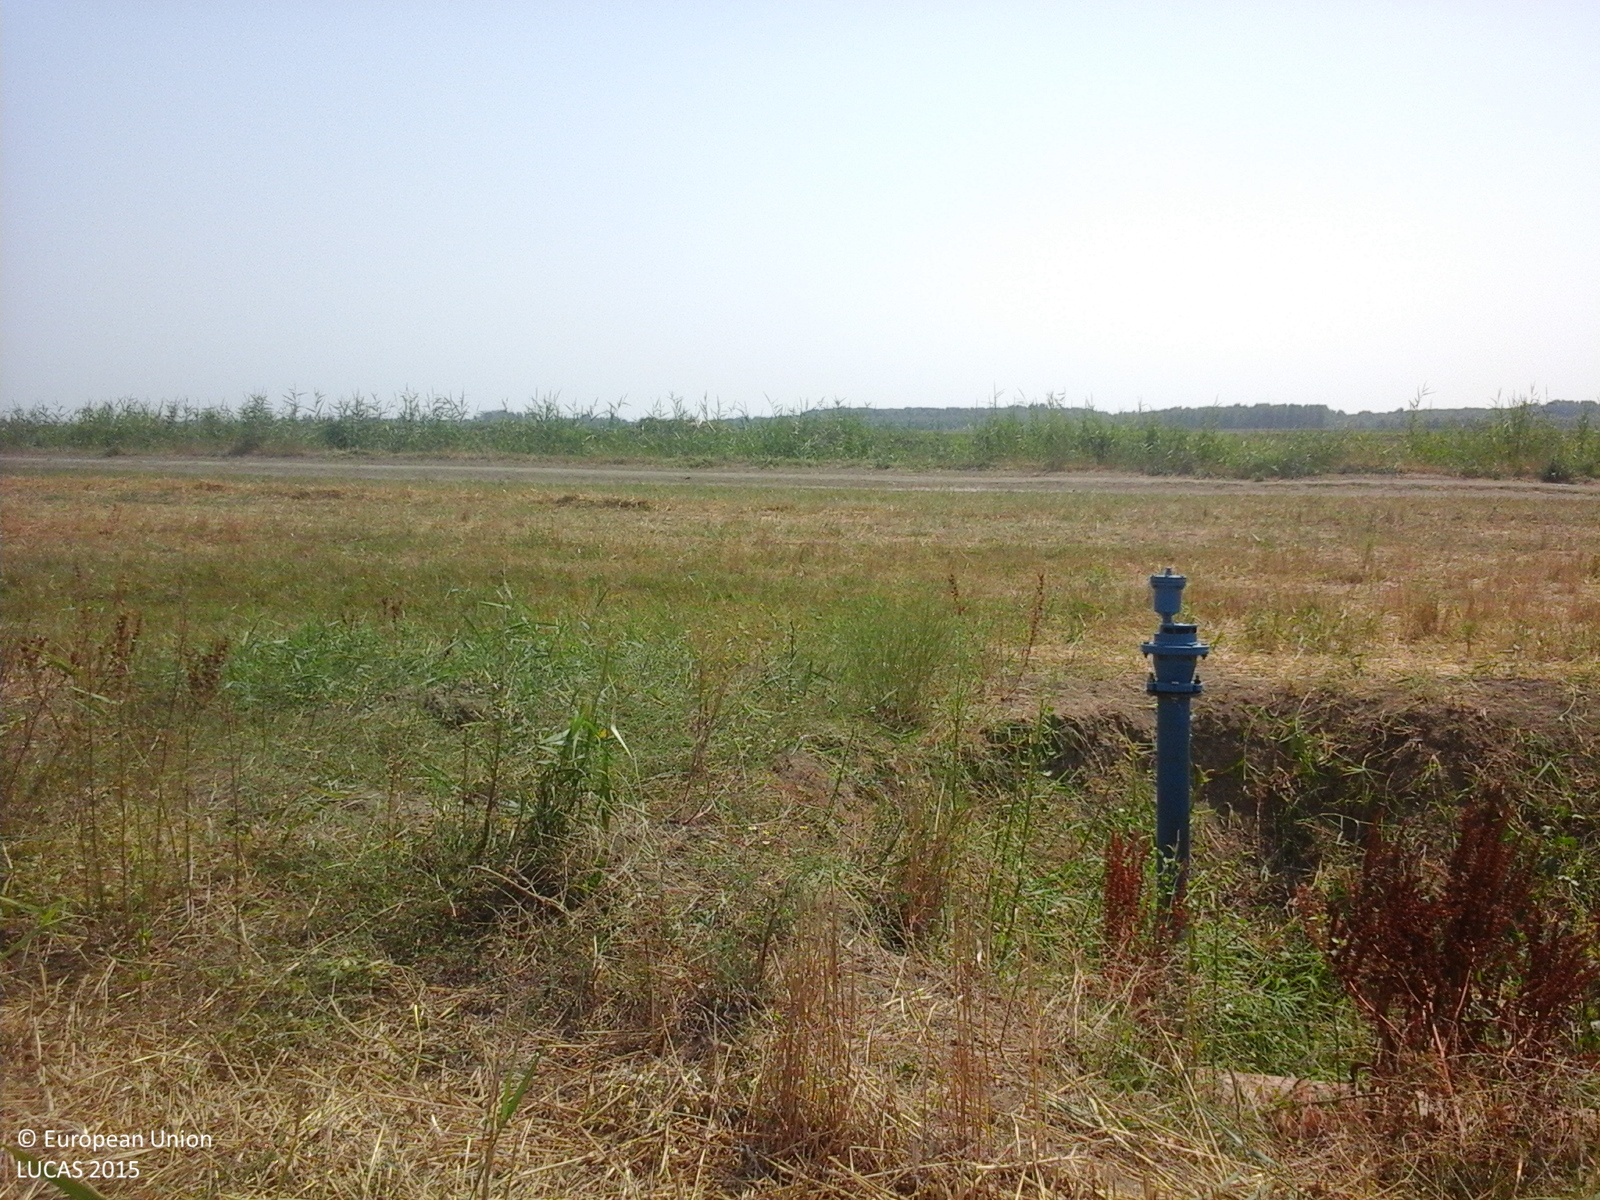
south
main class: Cropland
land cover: Maize
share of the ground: > 75 %
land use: Agriculture (excluding fallow land and kitchen gardens)
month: July
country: RO
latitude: 45.4341
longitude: 27.7890
